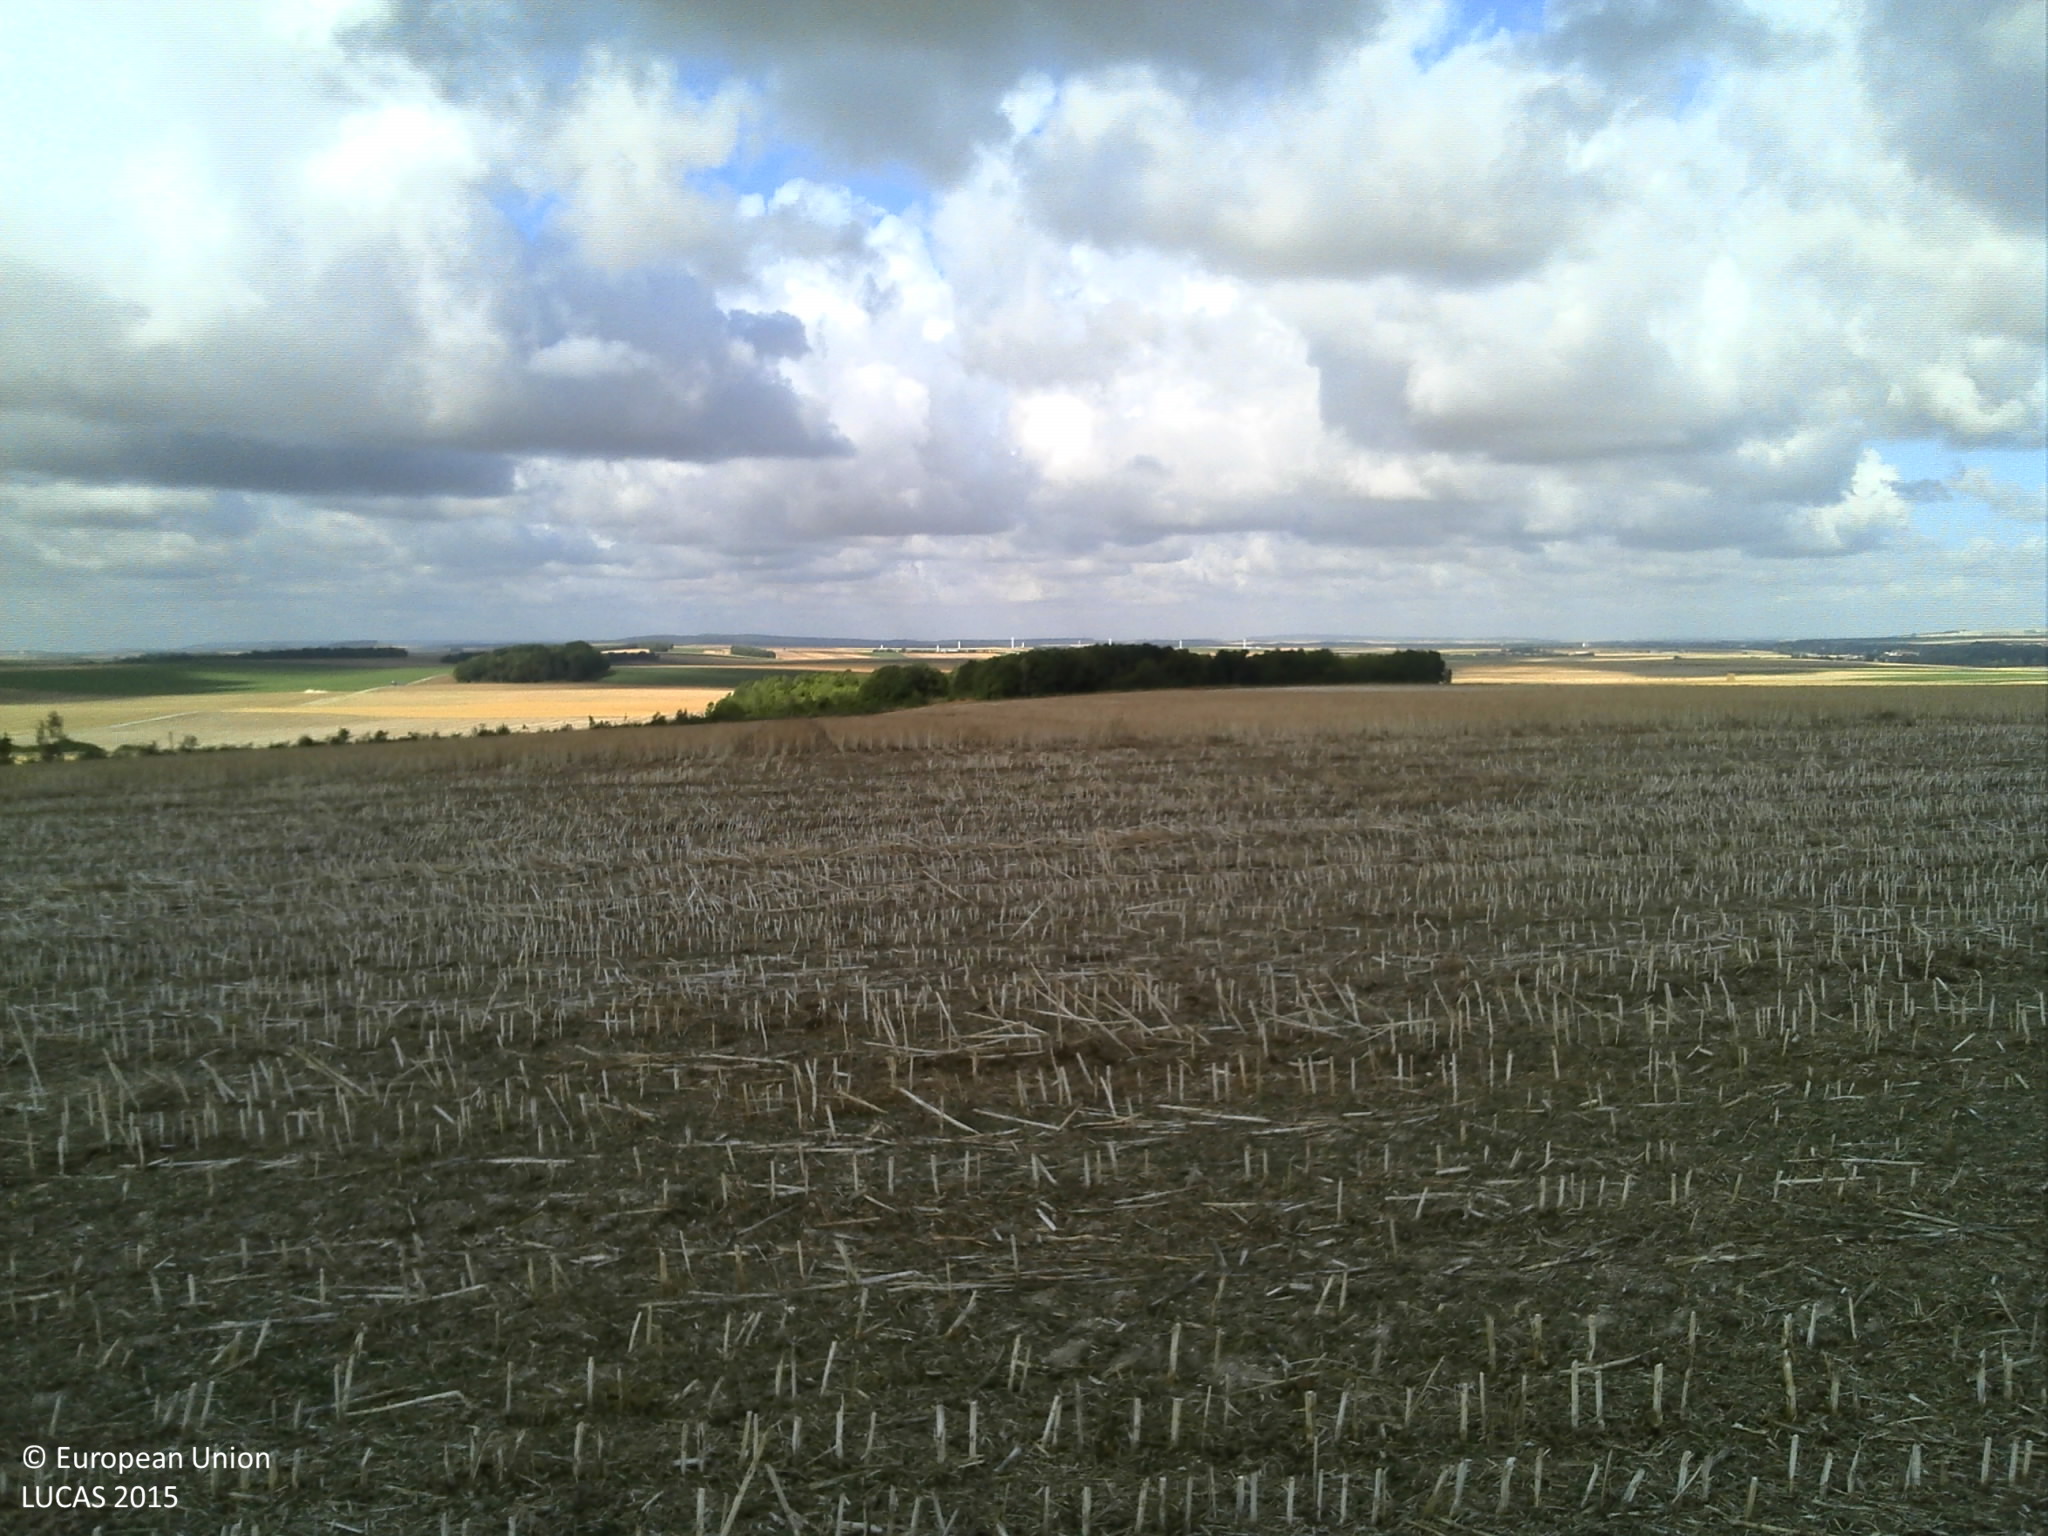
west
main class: Cropland
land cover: Rape and turnip rape
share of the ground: 25 - 50 %
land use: Agriculture (excluding fallow land and kitchen gardens)
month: July
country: FR
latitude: 49.2949
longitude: 4.5100
